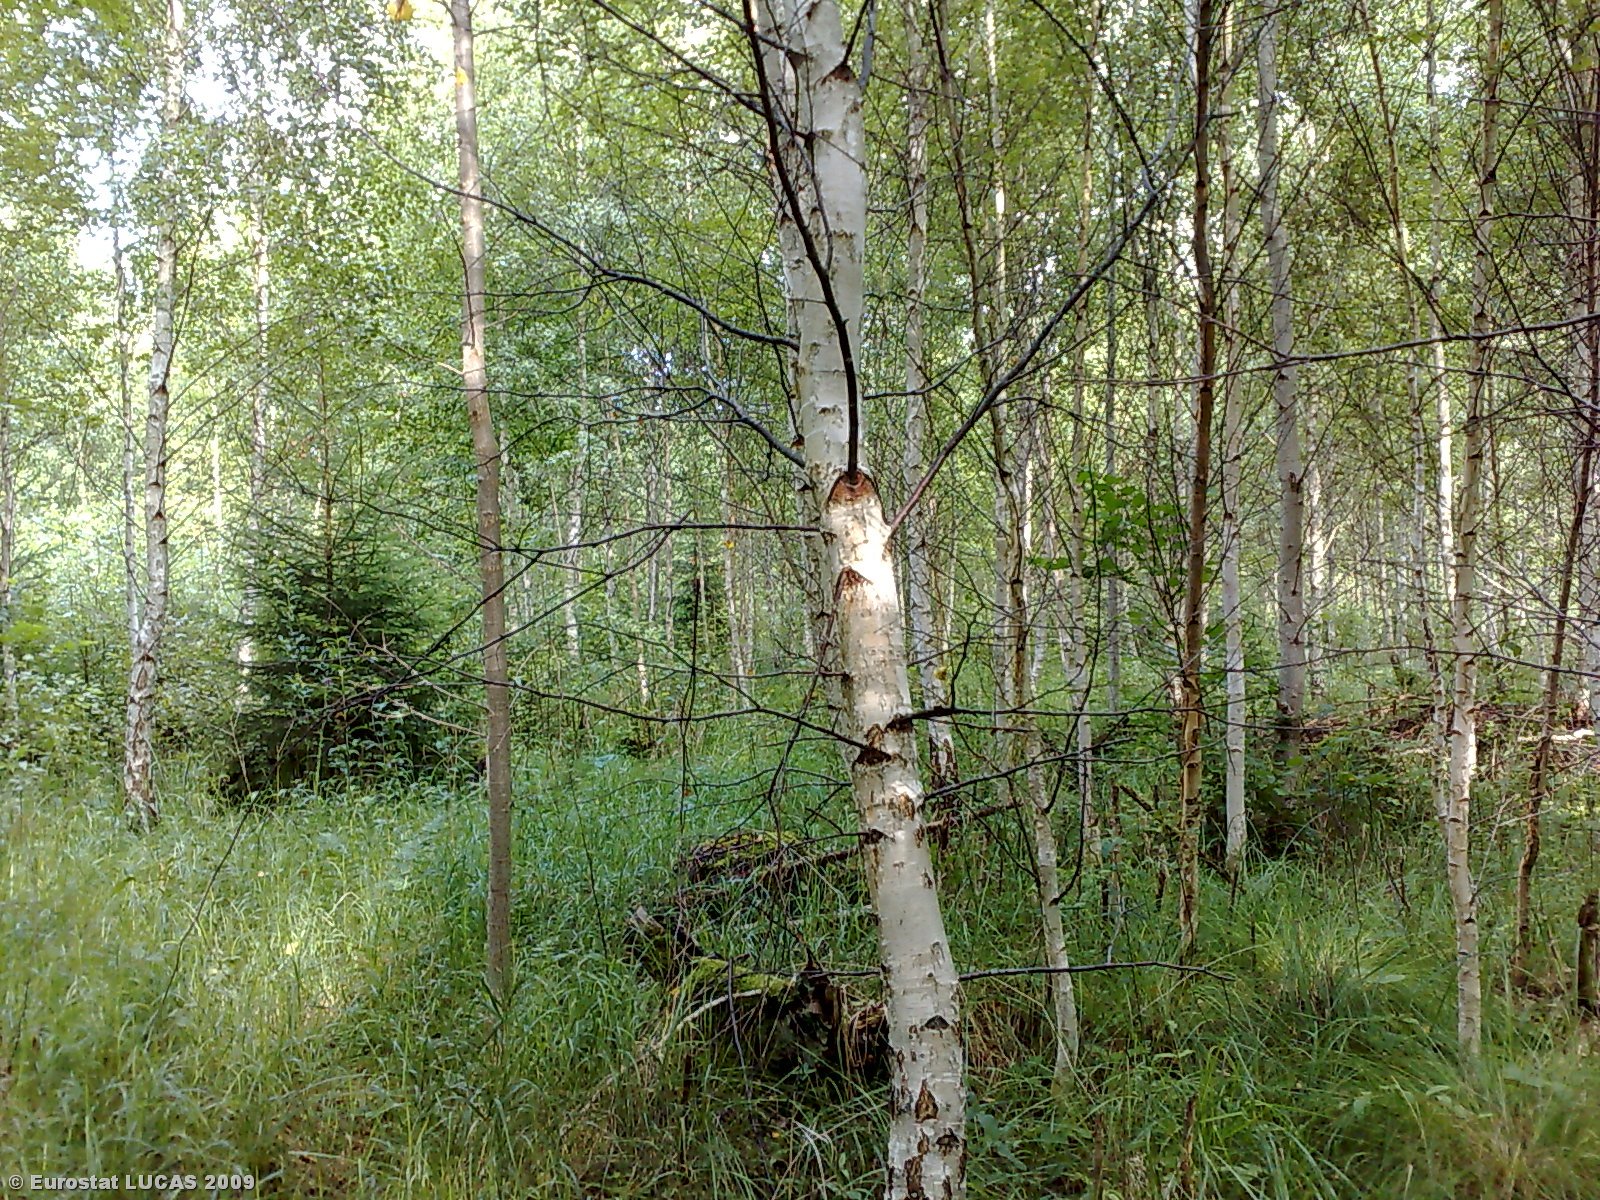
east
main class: Woodland
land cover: Mixed woodland
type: boreal forest
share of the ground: > 75 %
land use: Forestry
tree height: > 5 m
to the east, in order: Mixed woodland; Broadleaved woodland
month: July
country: LT
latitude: 56.2176
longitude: 22.9833
